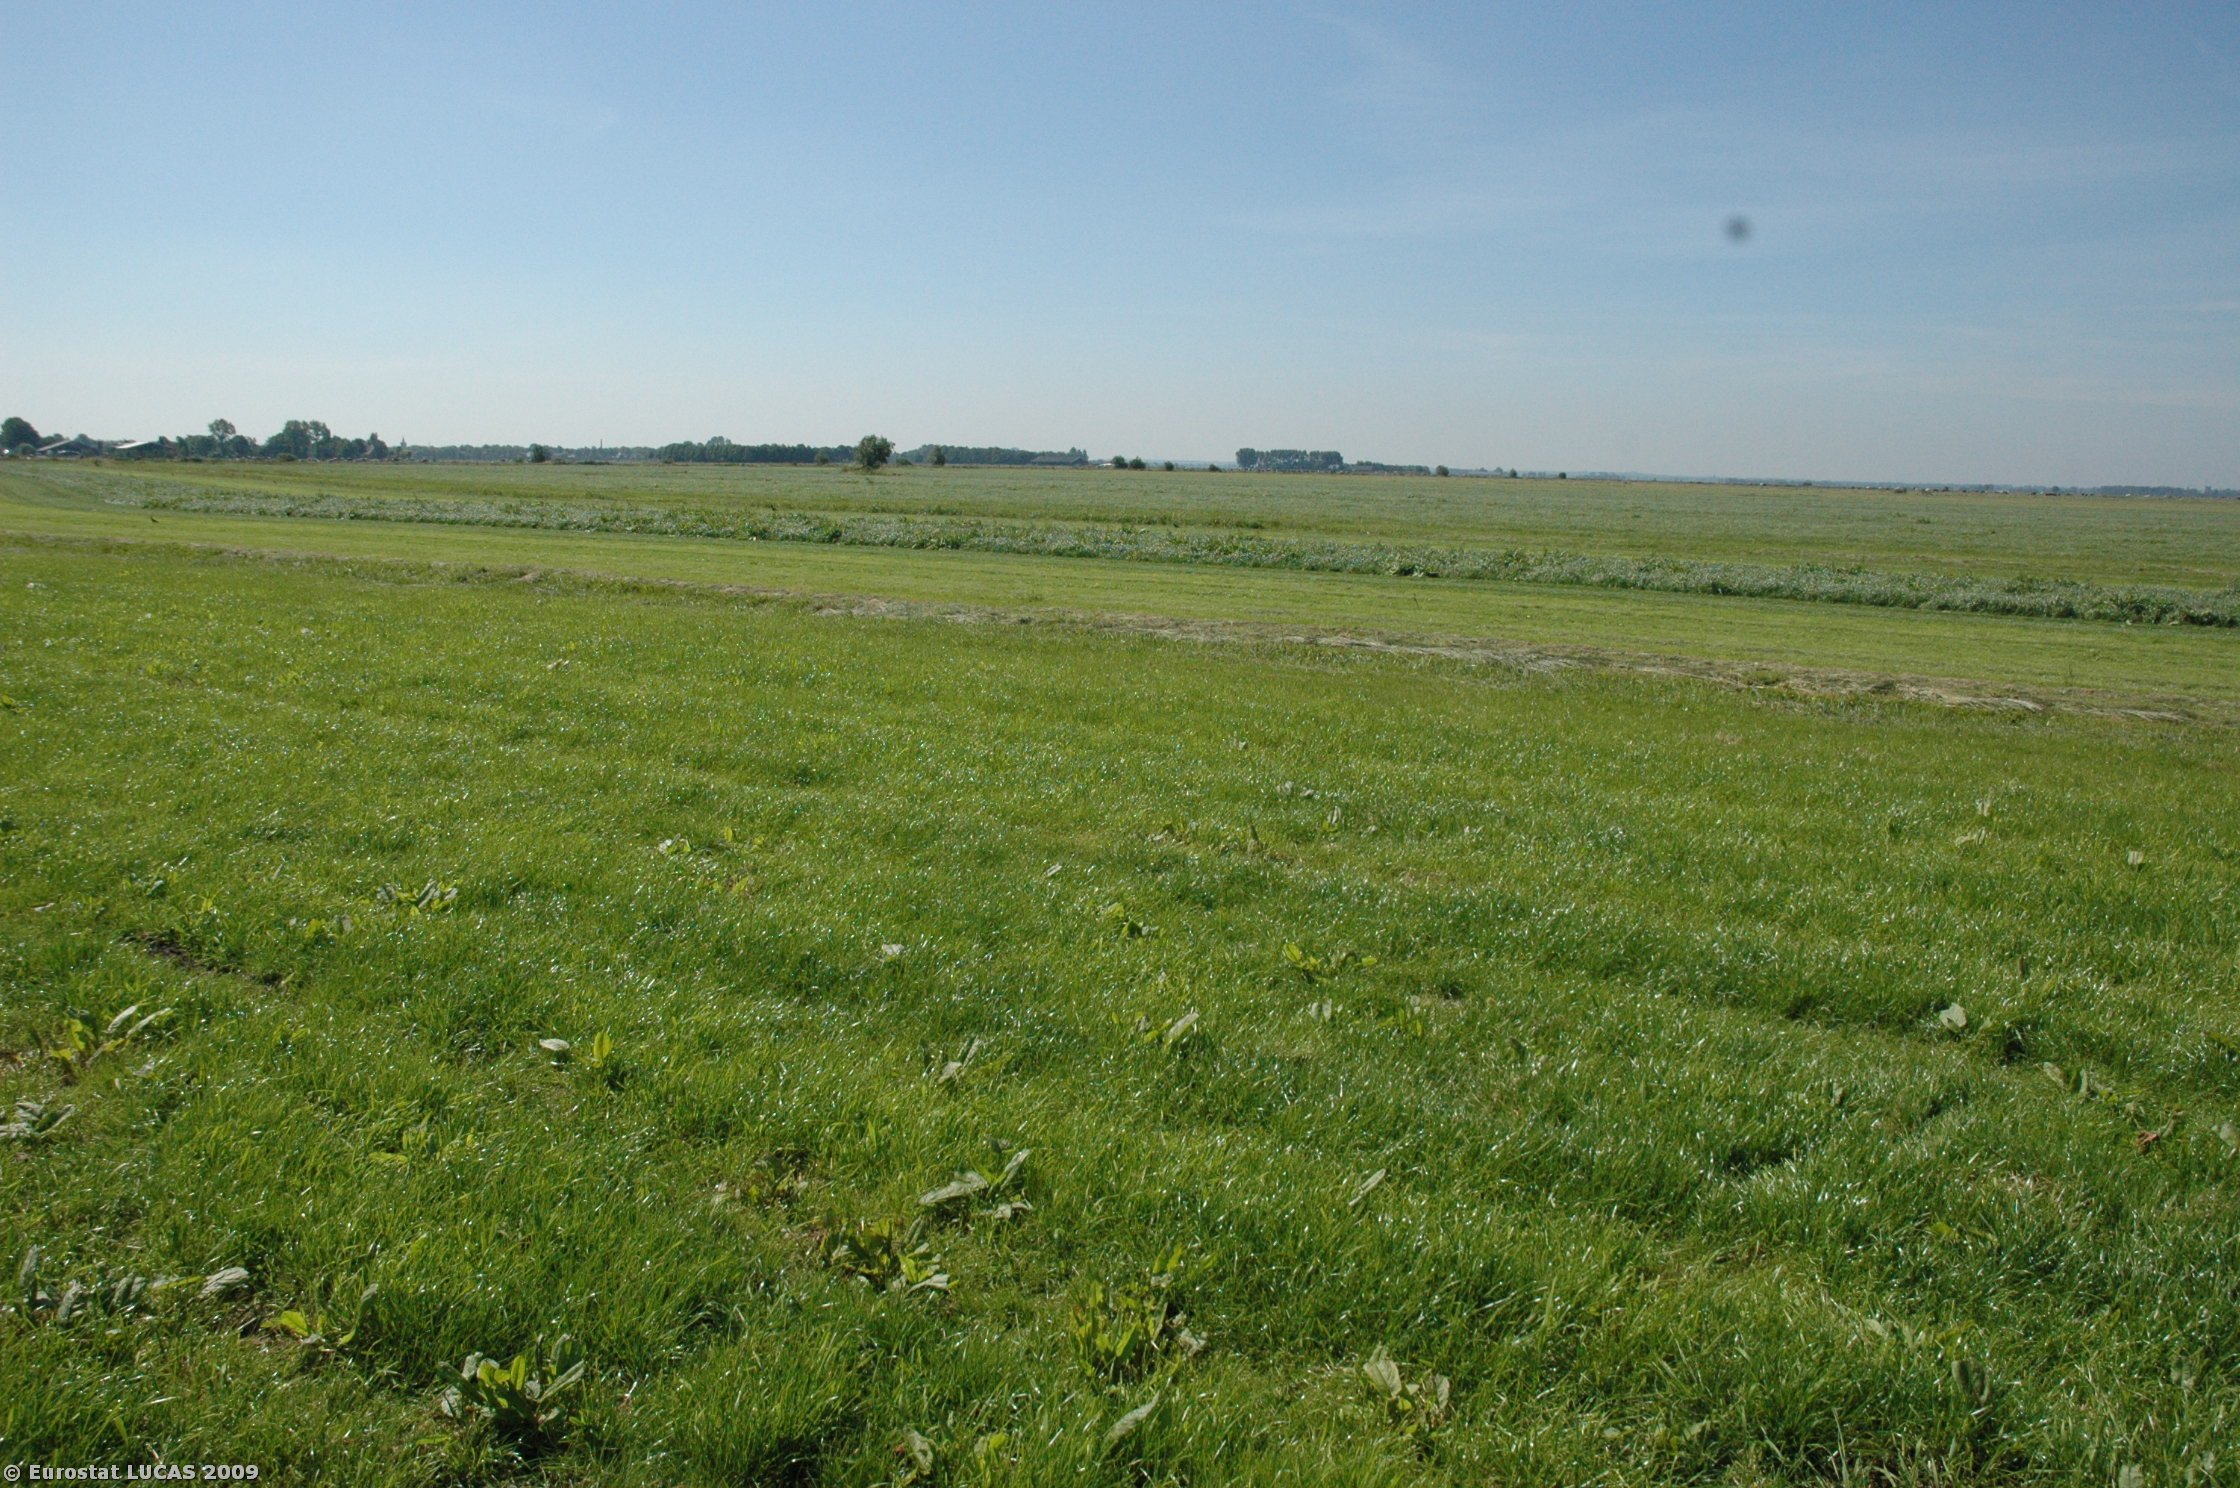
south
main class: Grassland
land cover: Grassland without tree/shrub cover
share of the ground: > 75 %
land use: Agriculture (excluding fallow land and kitchen gardens)
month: June
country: NL
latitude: 52.2685
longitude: 5.3528
